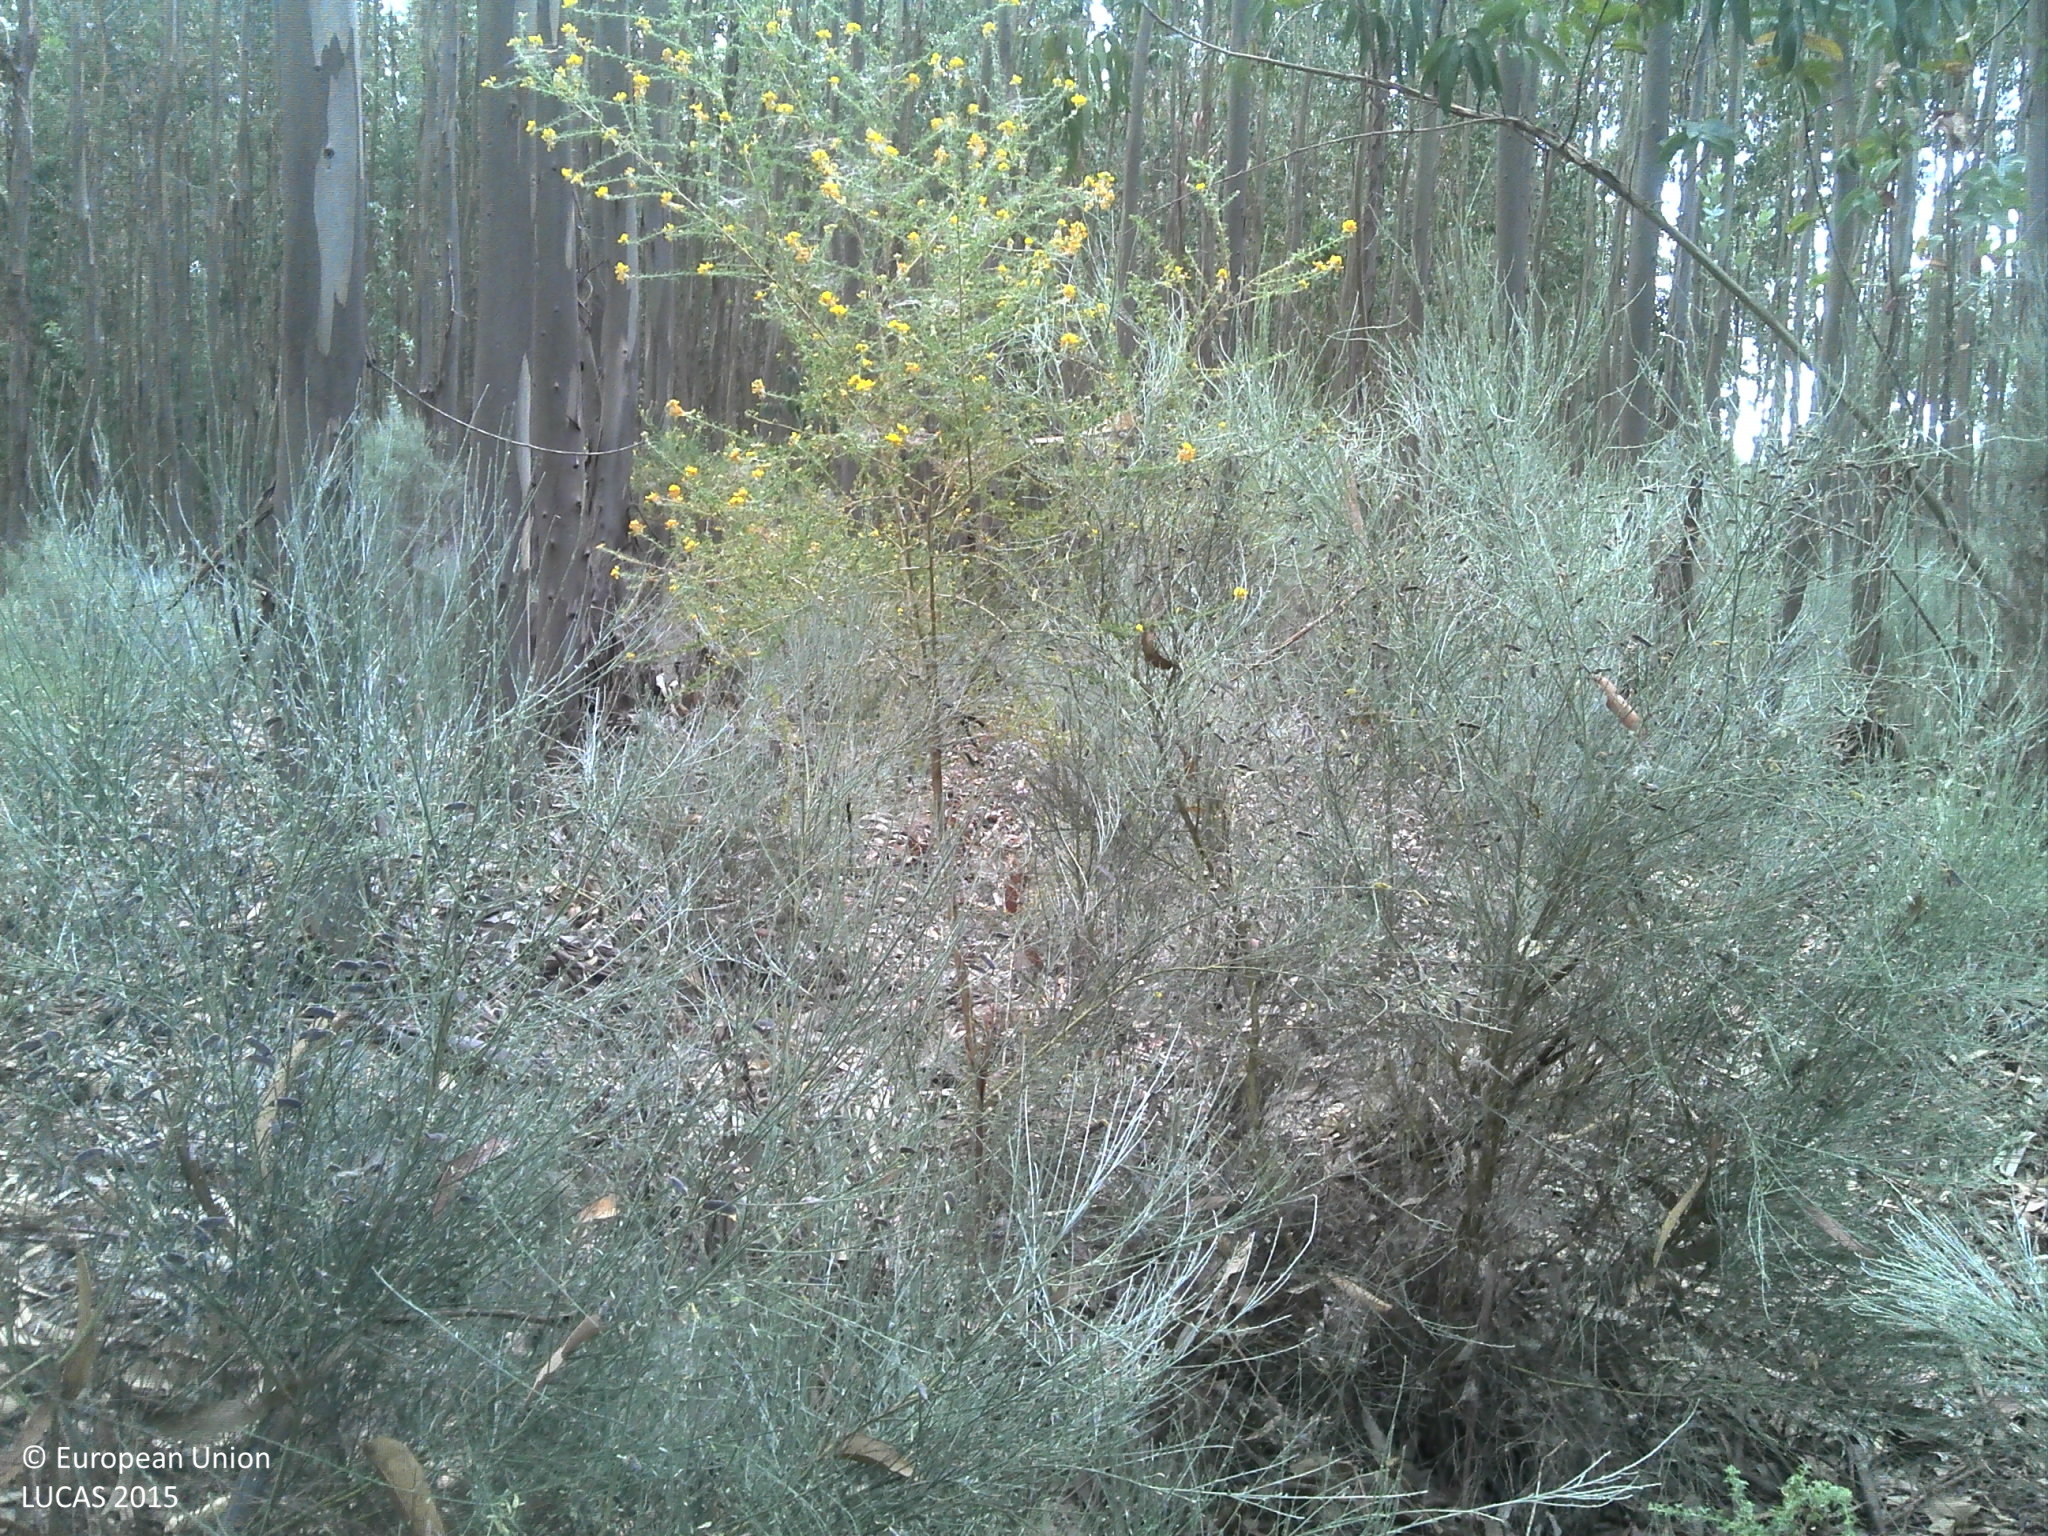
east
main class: Woodland
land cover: Broadleaved woodland
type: exotic forest
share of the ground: 50 - 75 %
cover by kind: broadleaved forest trees 60 %, shrubs 20 %, unconsolidated bare surface 20 %
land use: Forestry
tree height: > 5 m
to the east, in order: Broadleaved woodland; Tracks; Broadleaved woodland
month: June
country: PT
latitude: 40.2402
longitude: -7.3467
